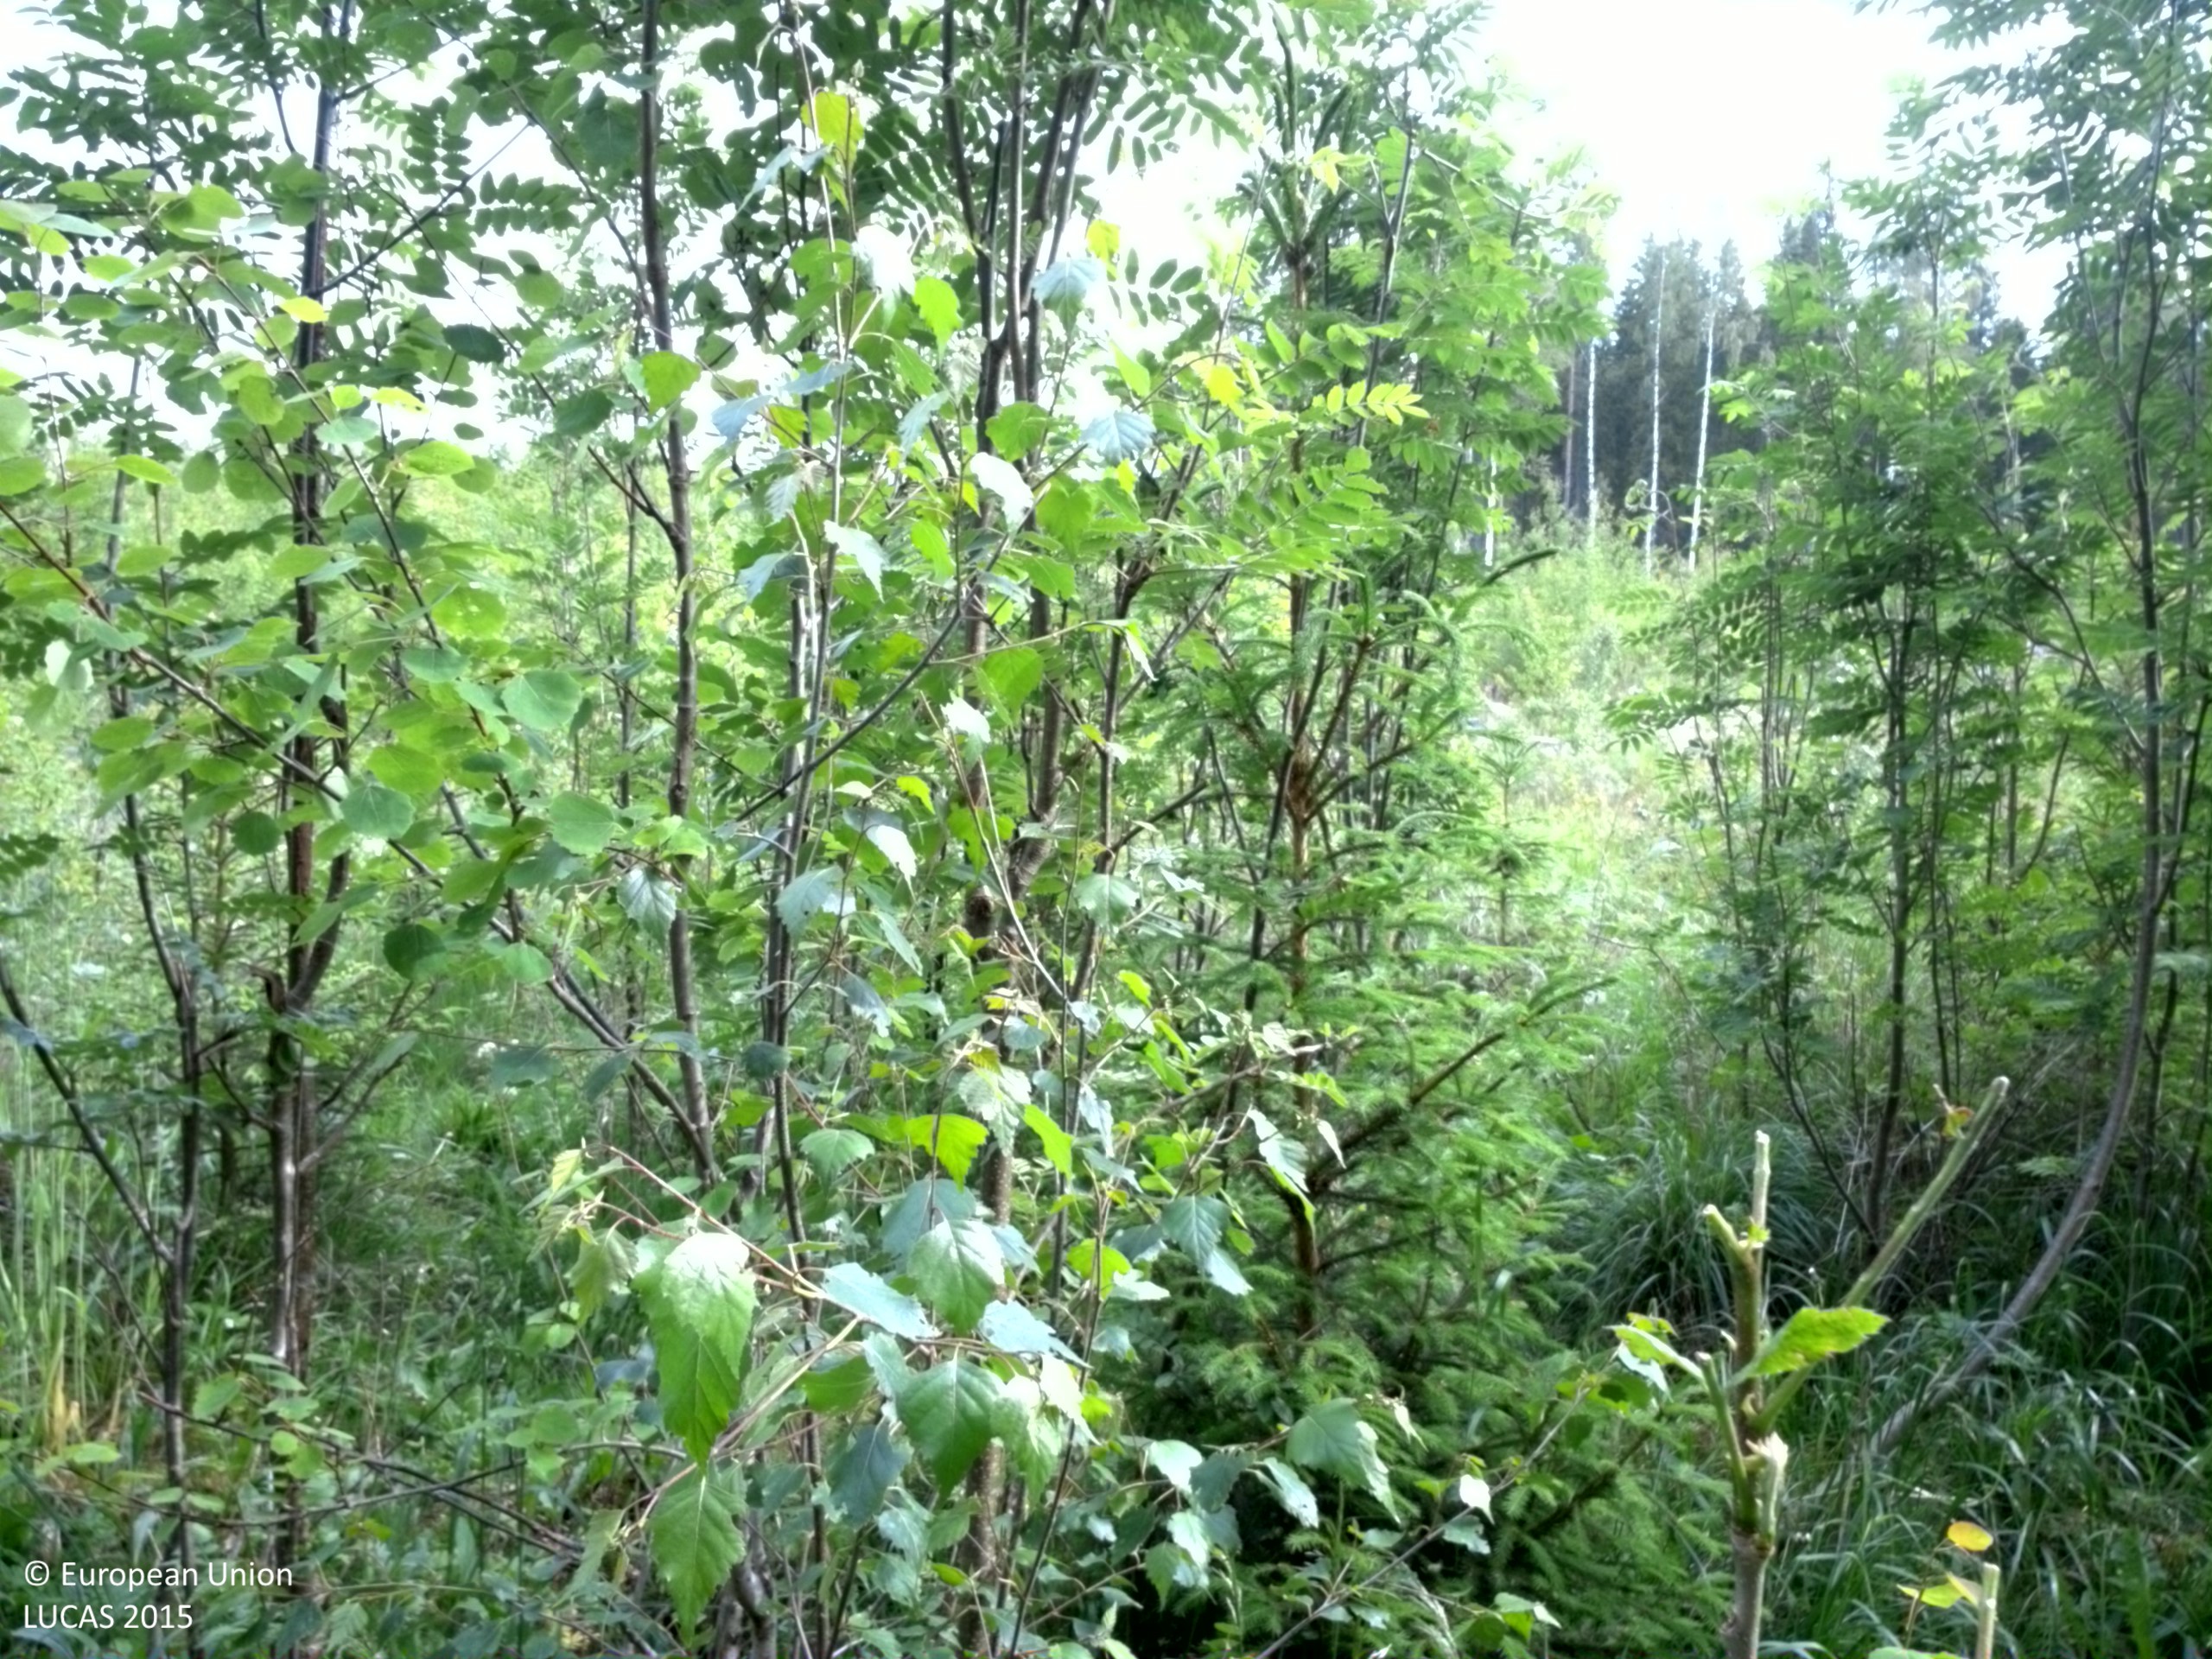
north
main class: Woodland
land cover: Broadleaved woodland
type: boreal forest
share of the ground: 25 - 50 %
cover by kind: herbaceous plants 55 %, broadleaved forest trees 35 %, coniferous forest trees 5 %, lichens and mosses 5 %
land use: Forestry
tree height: < 5 m
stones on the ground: < 10 %
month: June
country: SE
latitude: 60.2374
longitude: 17.7769
